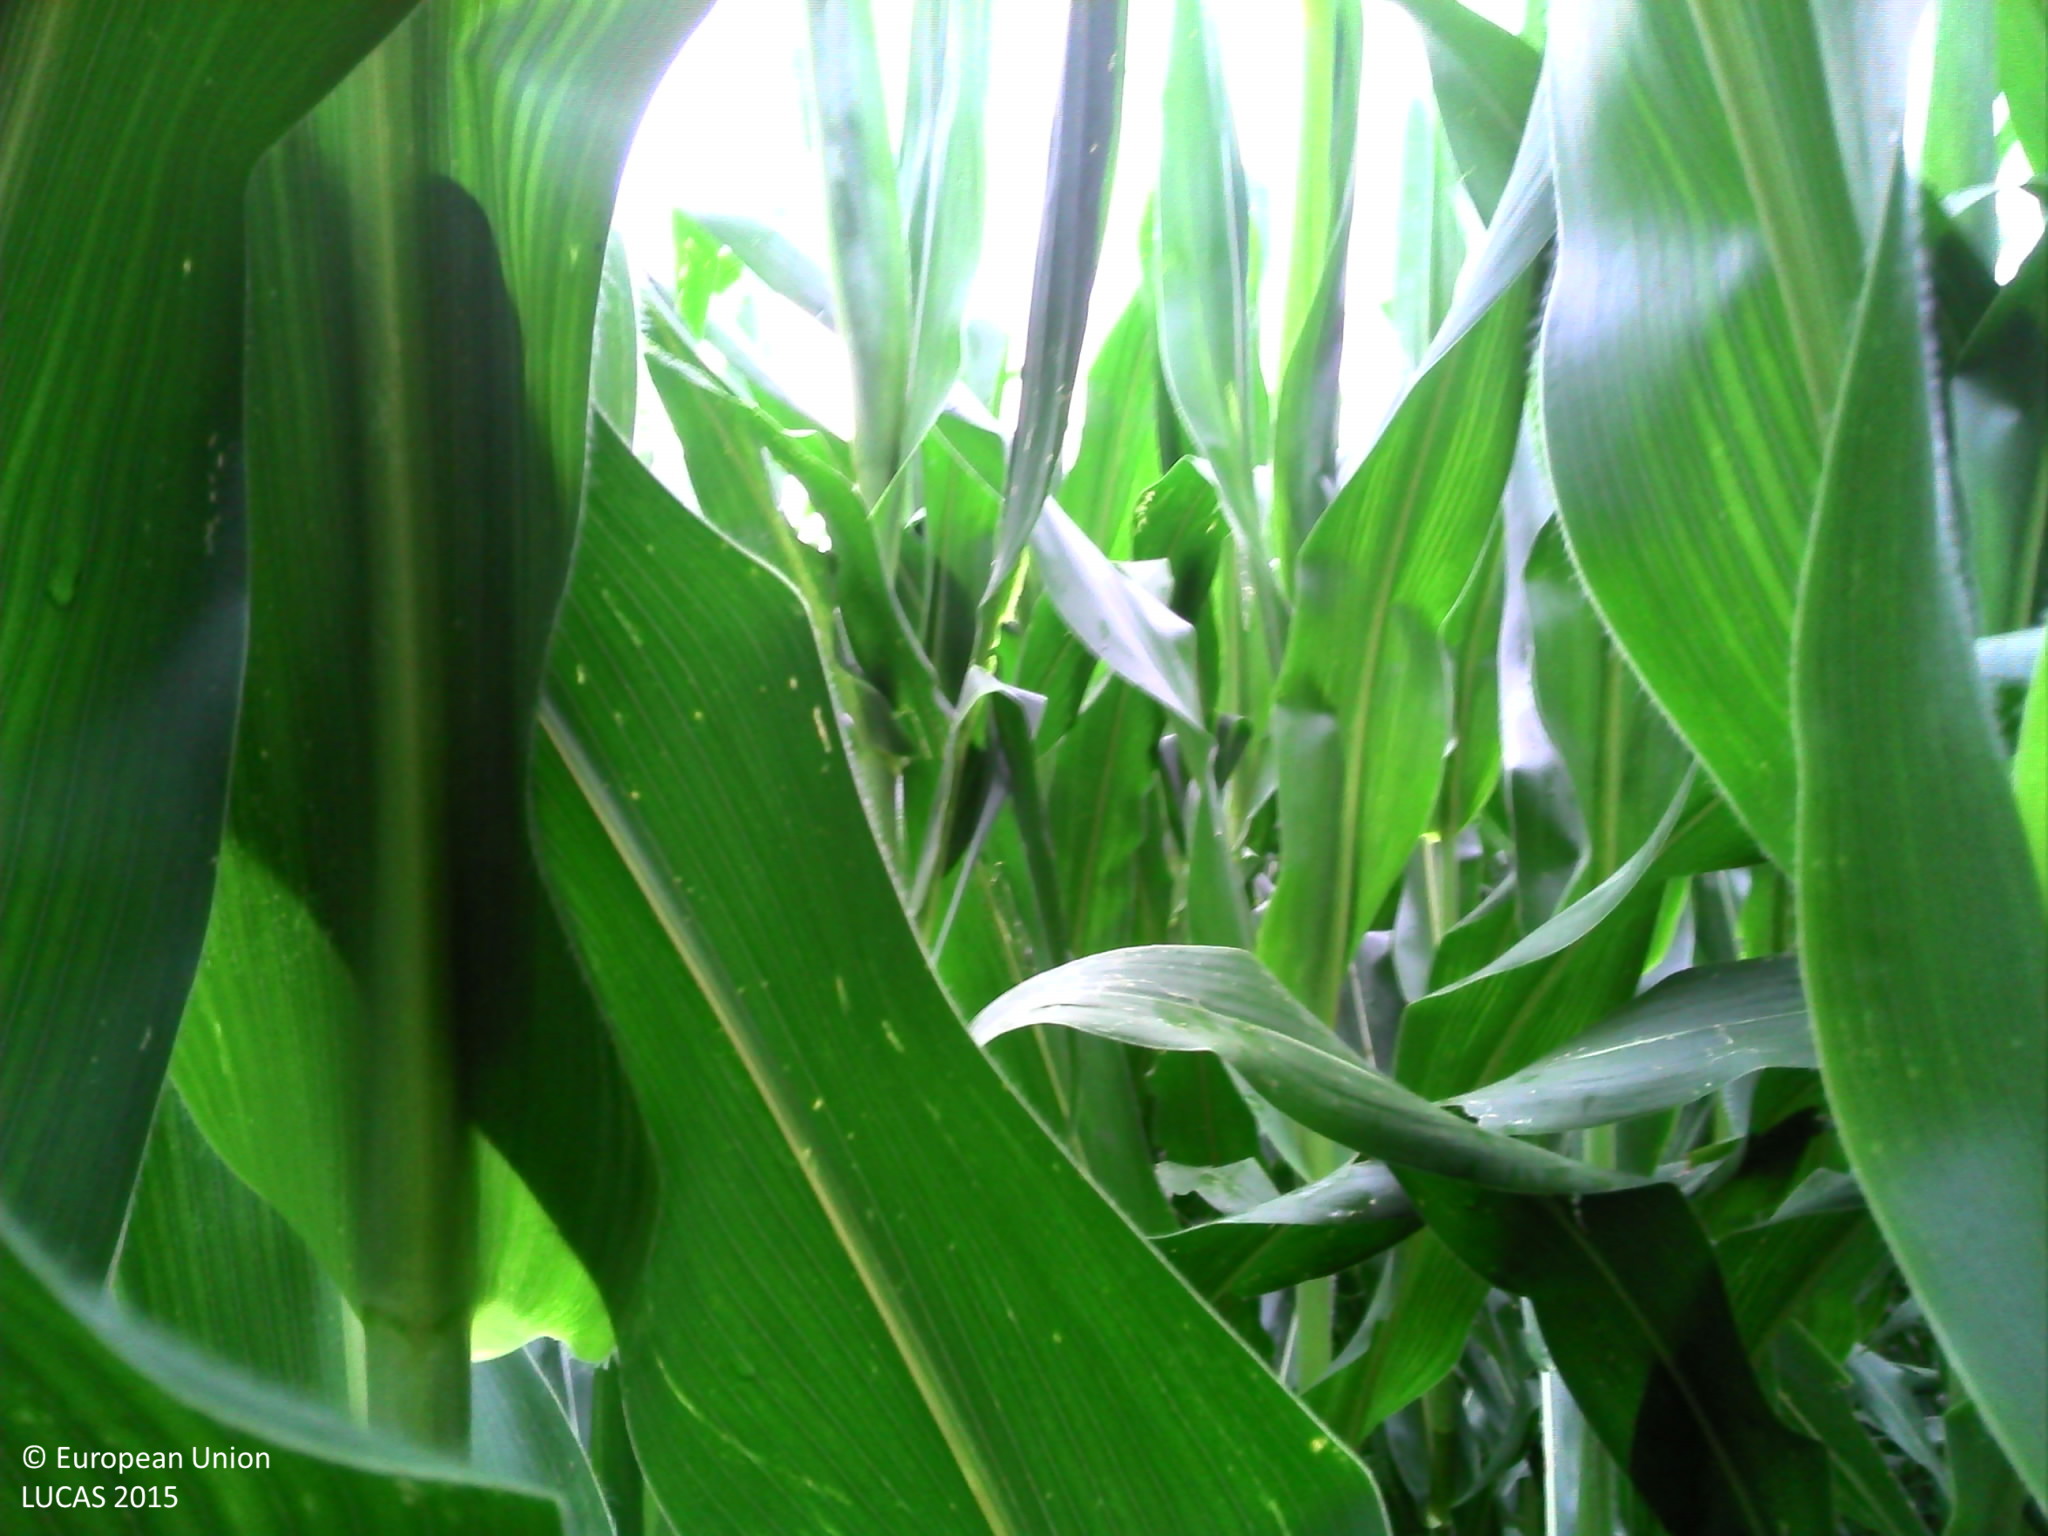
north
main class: Cropland
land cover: Maize
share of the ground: > 75 %
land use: Agriculture (excluding fallow land and kitchen gardens)
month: August
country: FR
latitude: 43.4307
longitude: -1.2197
